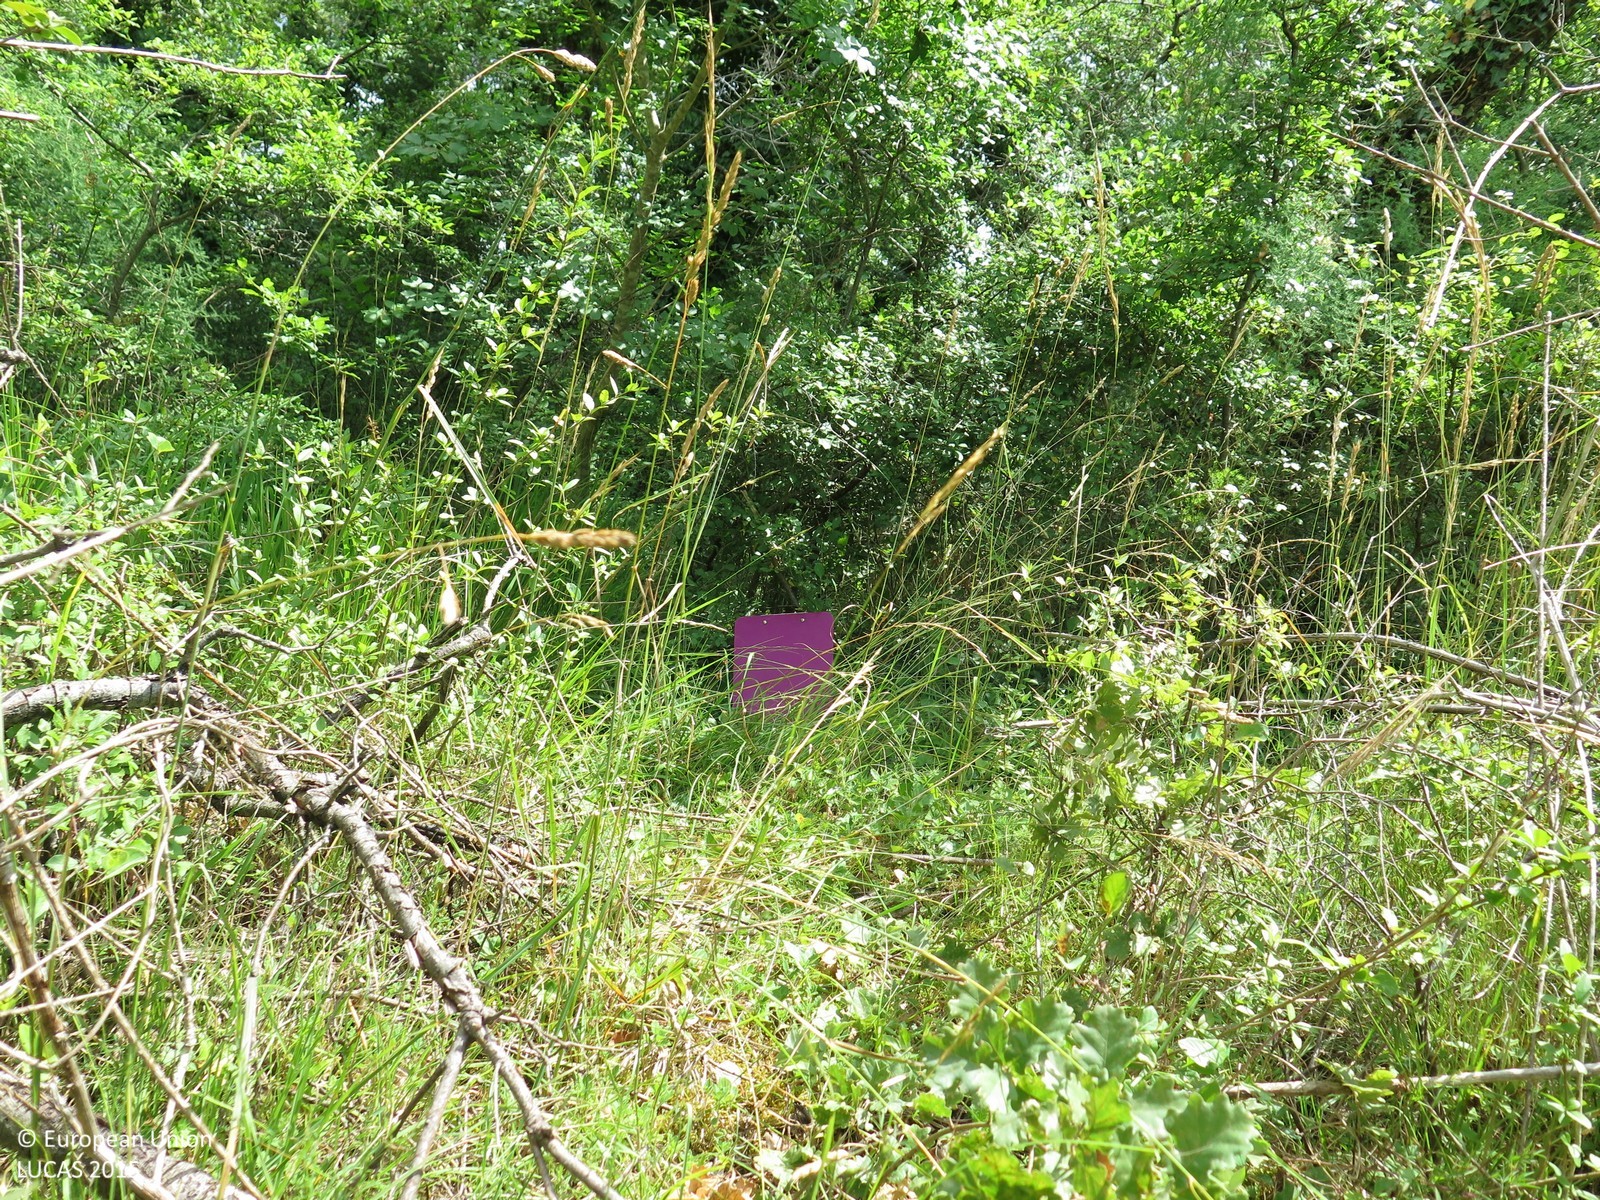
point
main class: Shrubland
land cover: Shrubland with sparse tree cover
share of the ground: > 75 %
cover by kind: shrubs 90 %, broadleaved forest trees 5 %, herbaceous plants 5 %
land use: Semi-natural and natural areas not in use
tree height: > 5 m
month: June
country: HR
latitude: 45.2753
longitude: 13.7553
